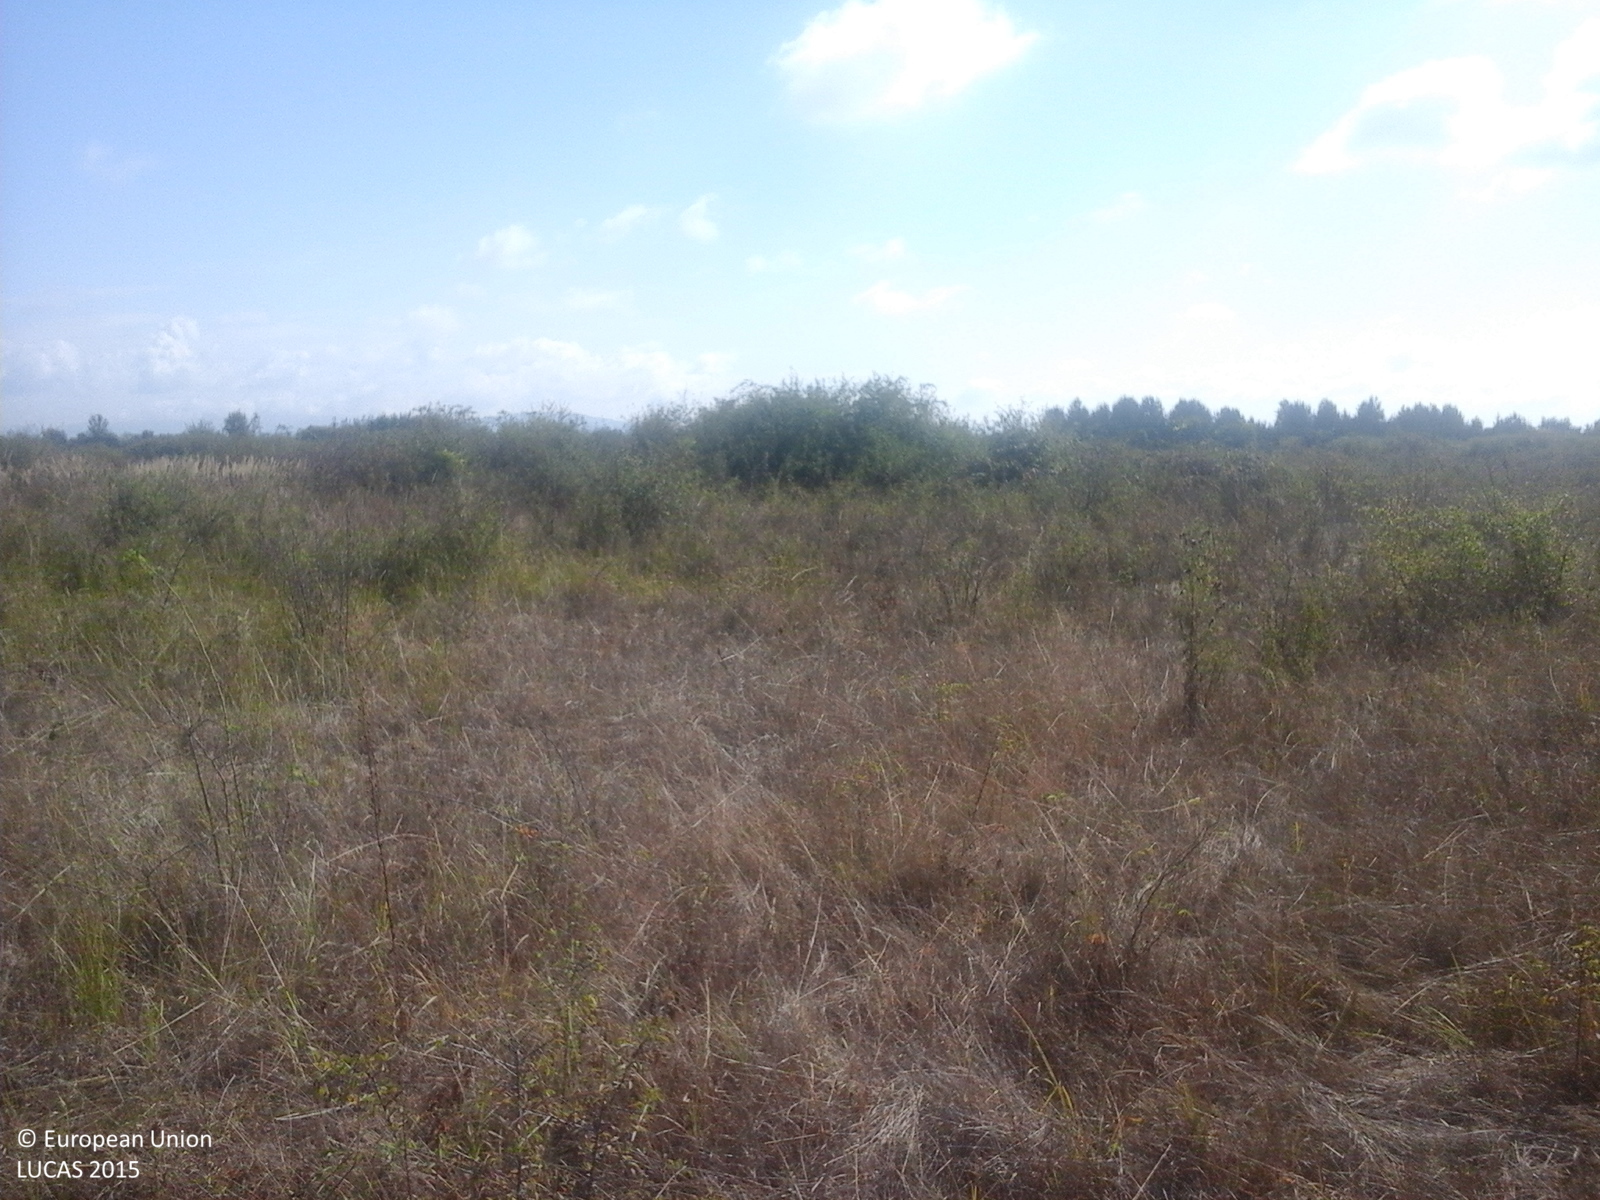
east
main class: Grassland
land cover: Spontaneously vegetated surfaces
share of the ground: > 75 %
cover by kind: herbaceous plants 100 %
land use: Fallow land
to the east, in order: Spontaneously vegetated surfaces; Grassland with sparse tree/shrub cover; Tracks; Grass margins; Ditches and canals; Grassland with sparse tree/shrub cover; Tracks; Grassland with sparse tree/shrub cover
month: September
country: RO
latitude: 47.9226
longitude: 23.0085
